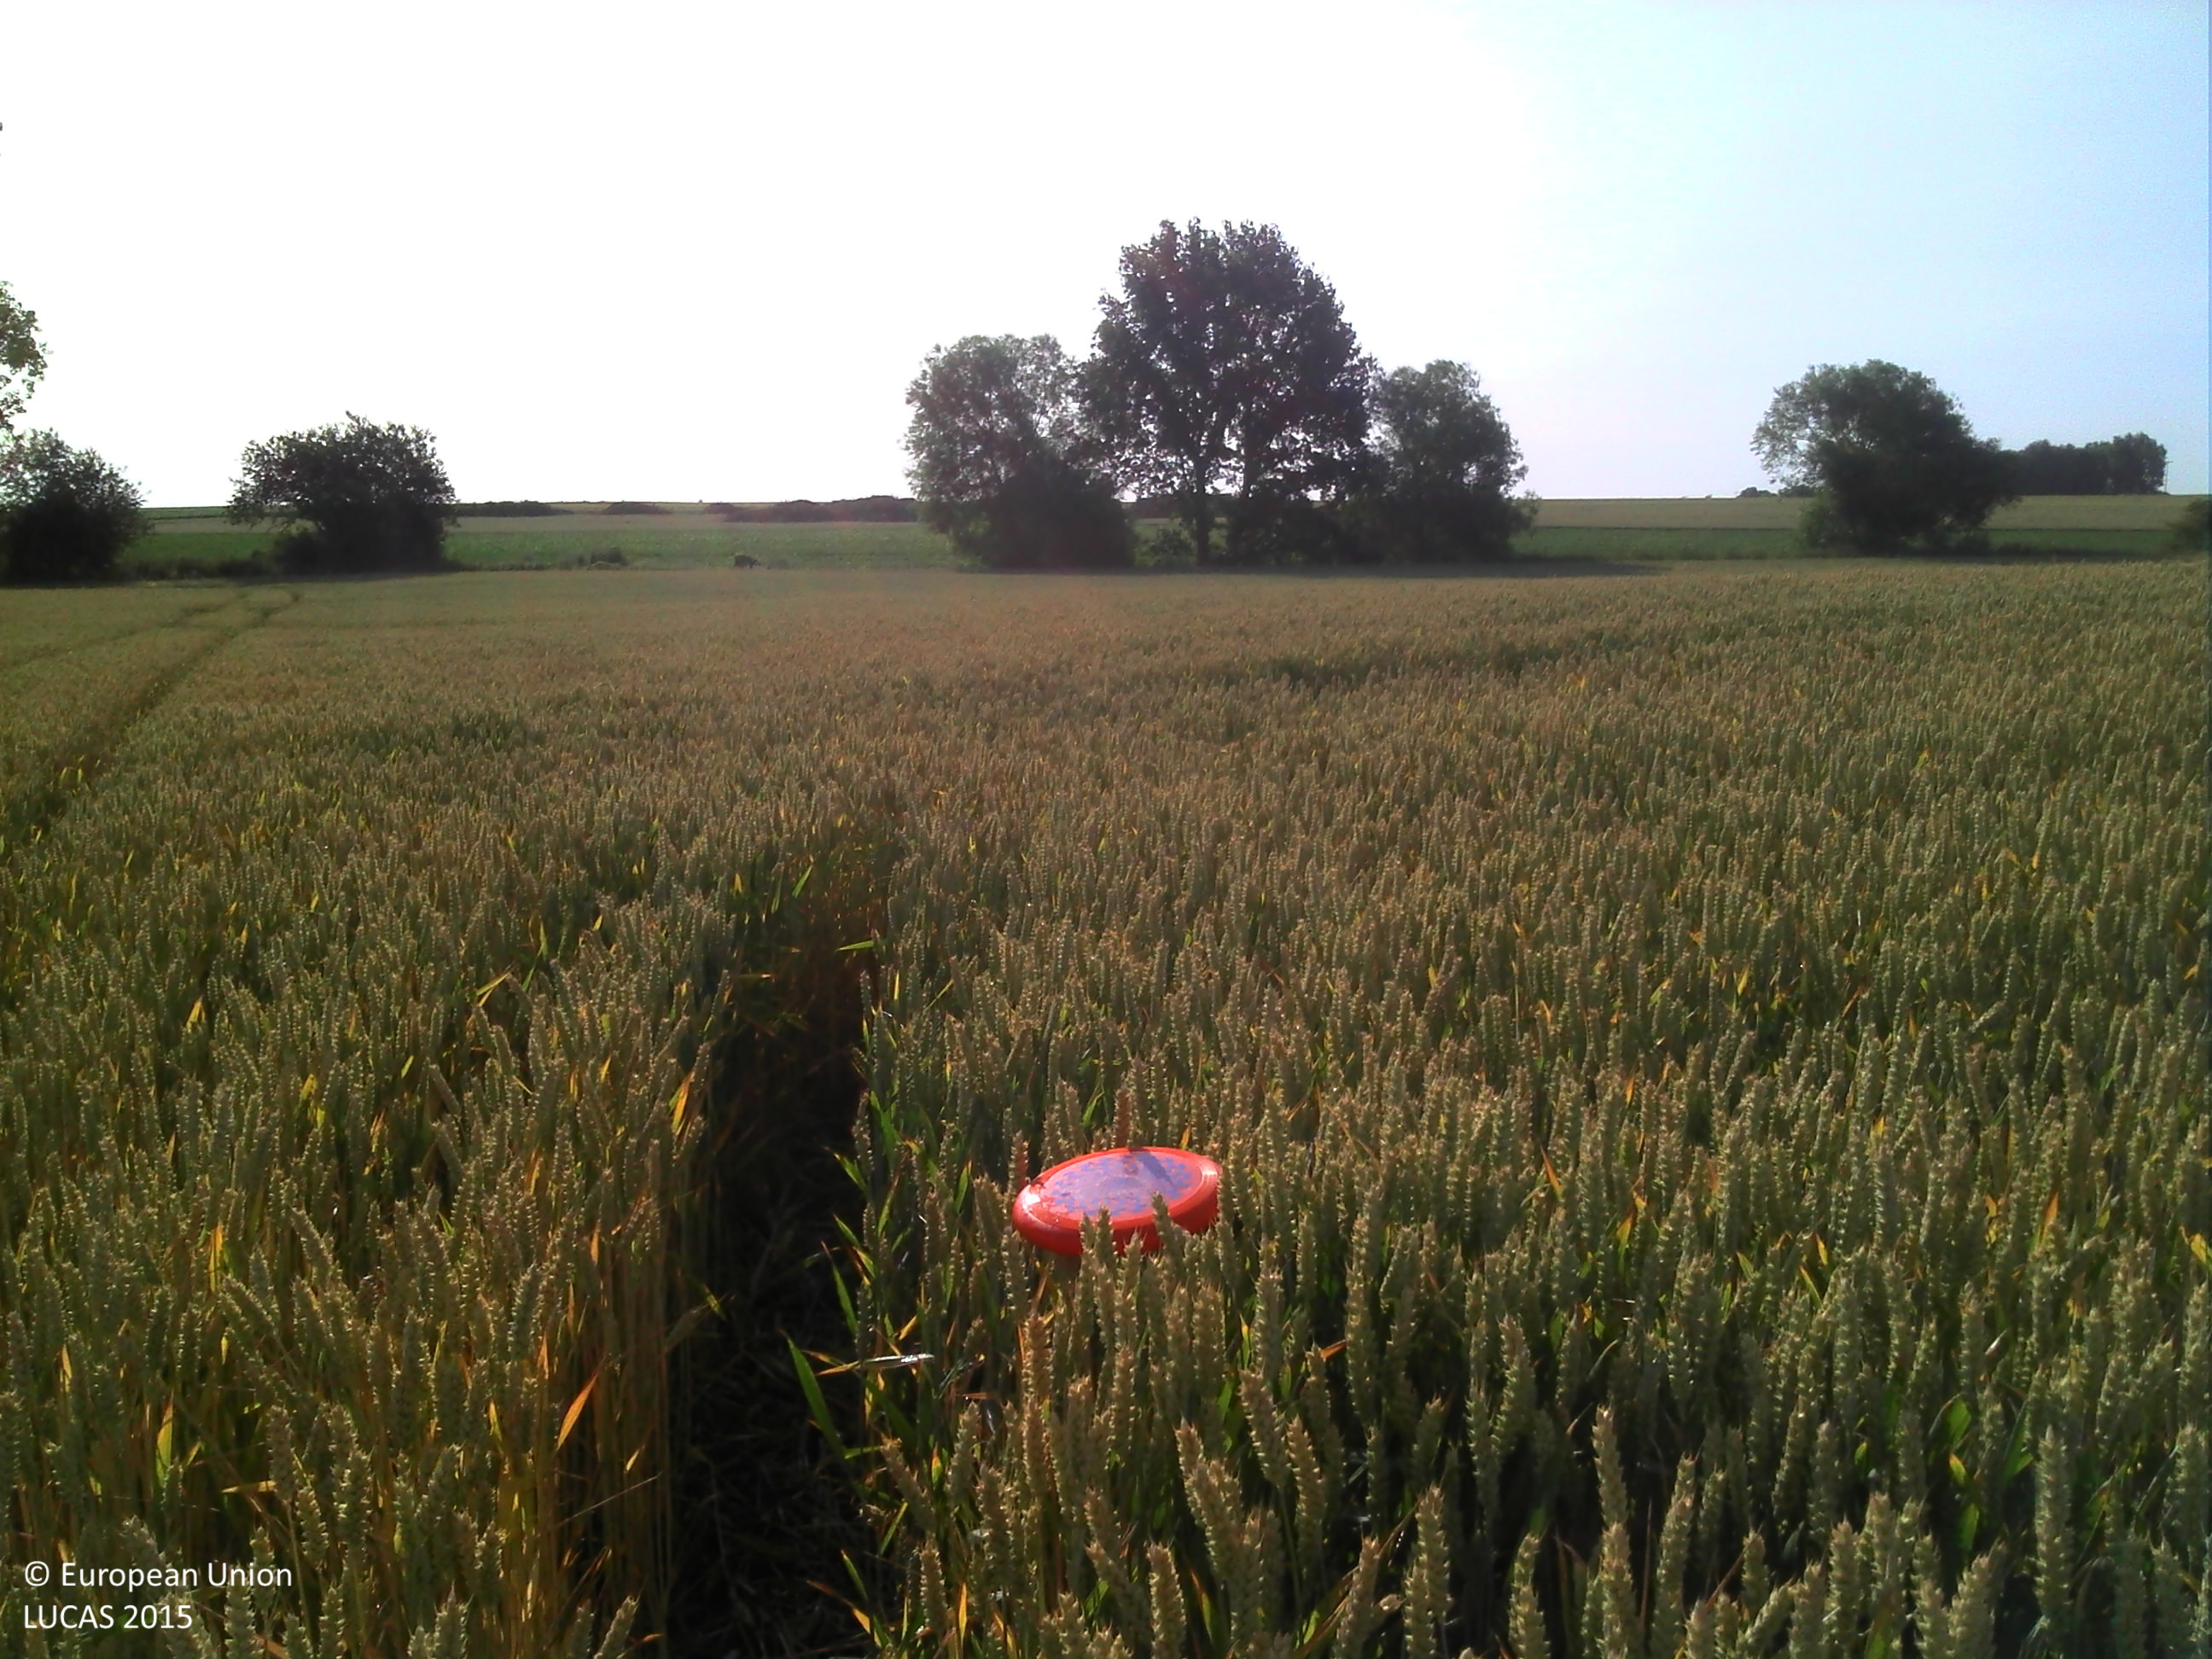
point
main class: Cropland
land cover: Common wheat
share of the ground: > 75 %
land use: Agriculture (excluding fallow land and kitchen gardens)
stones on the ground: < 10 %
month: July
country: BE
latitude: 50.7099
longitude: 5.1117
